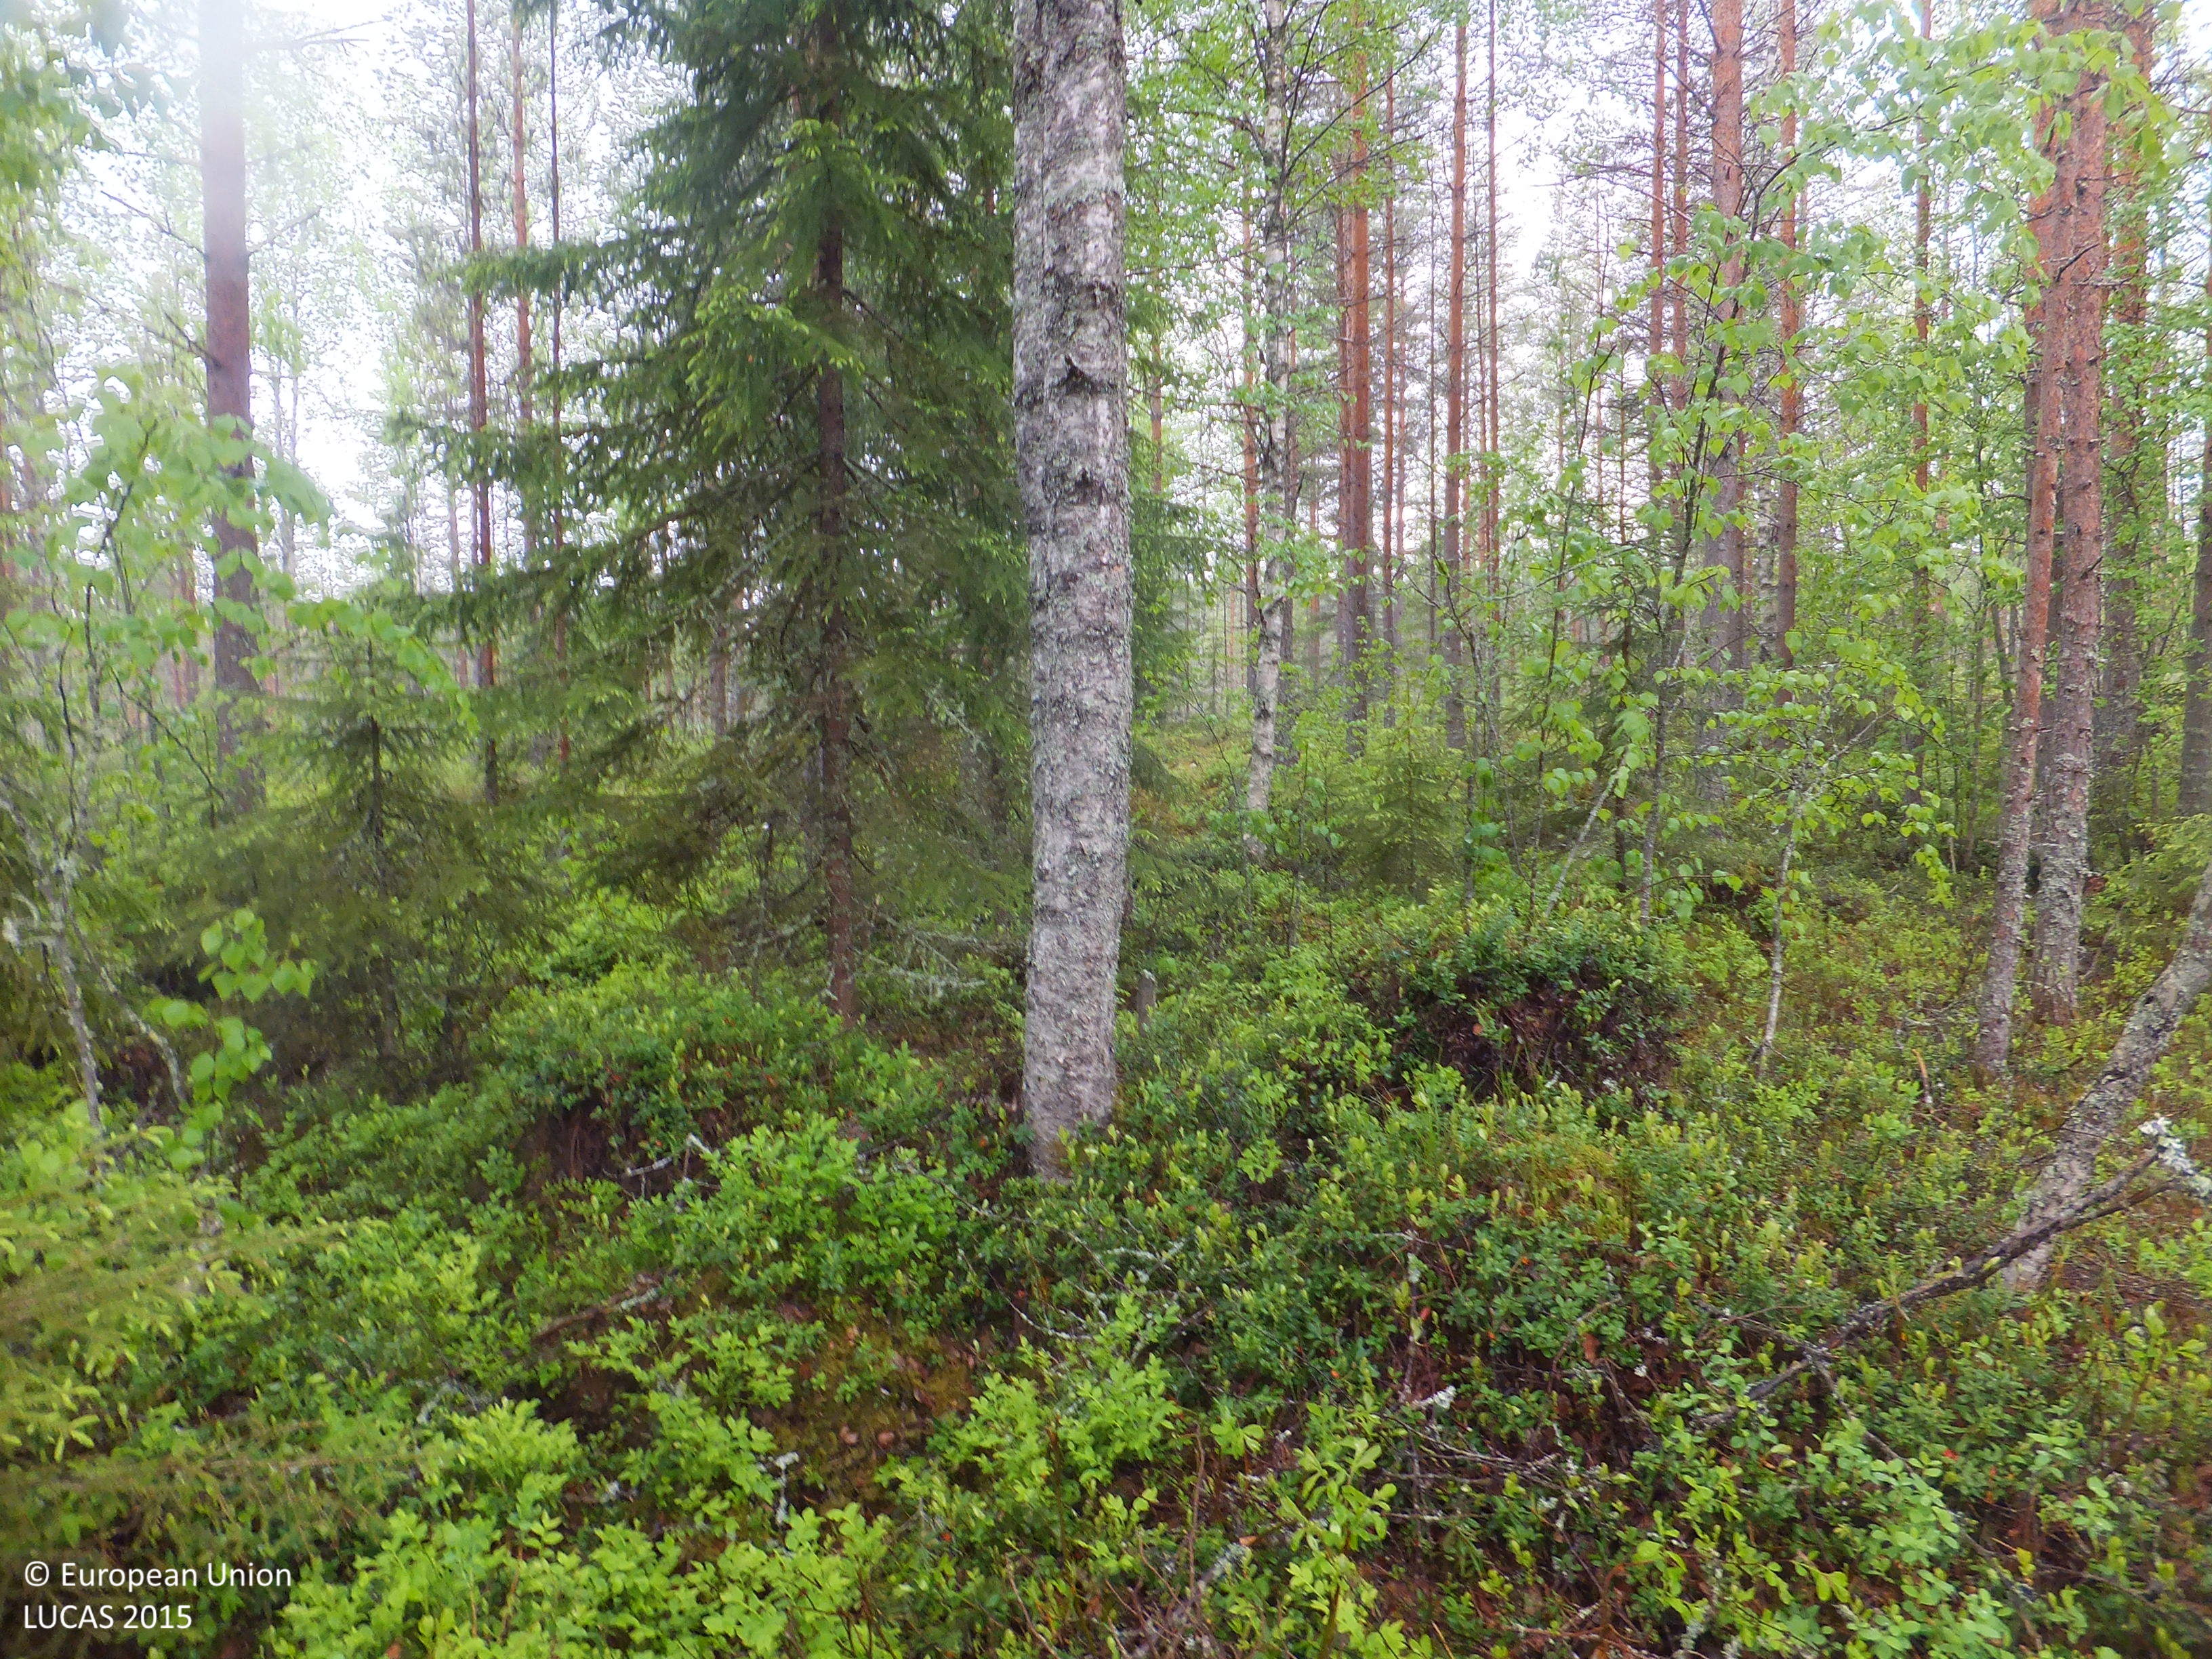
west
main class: Woodland
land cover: Pine dominated coniferous woodland
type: boreal forest
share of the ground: > 75 %
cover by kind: coniferous forest trees 80 %, shrubs 15 %, broadleaved forest trees 5 %
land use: Forestry
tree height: > 5 m
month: June
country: FI
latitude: 63.7135
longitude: 24.8387
